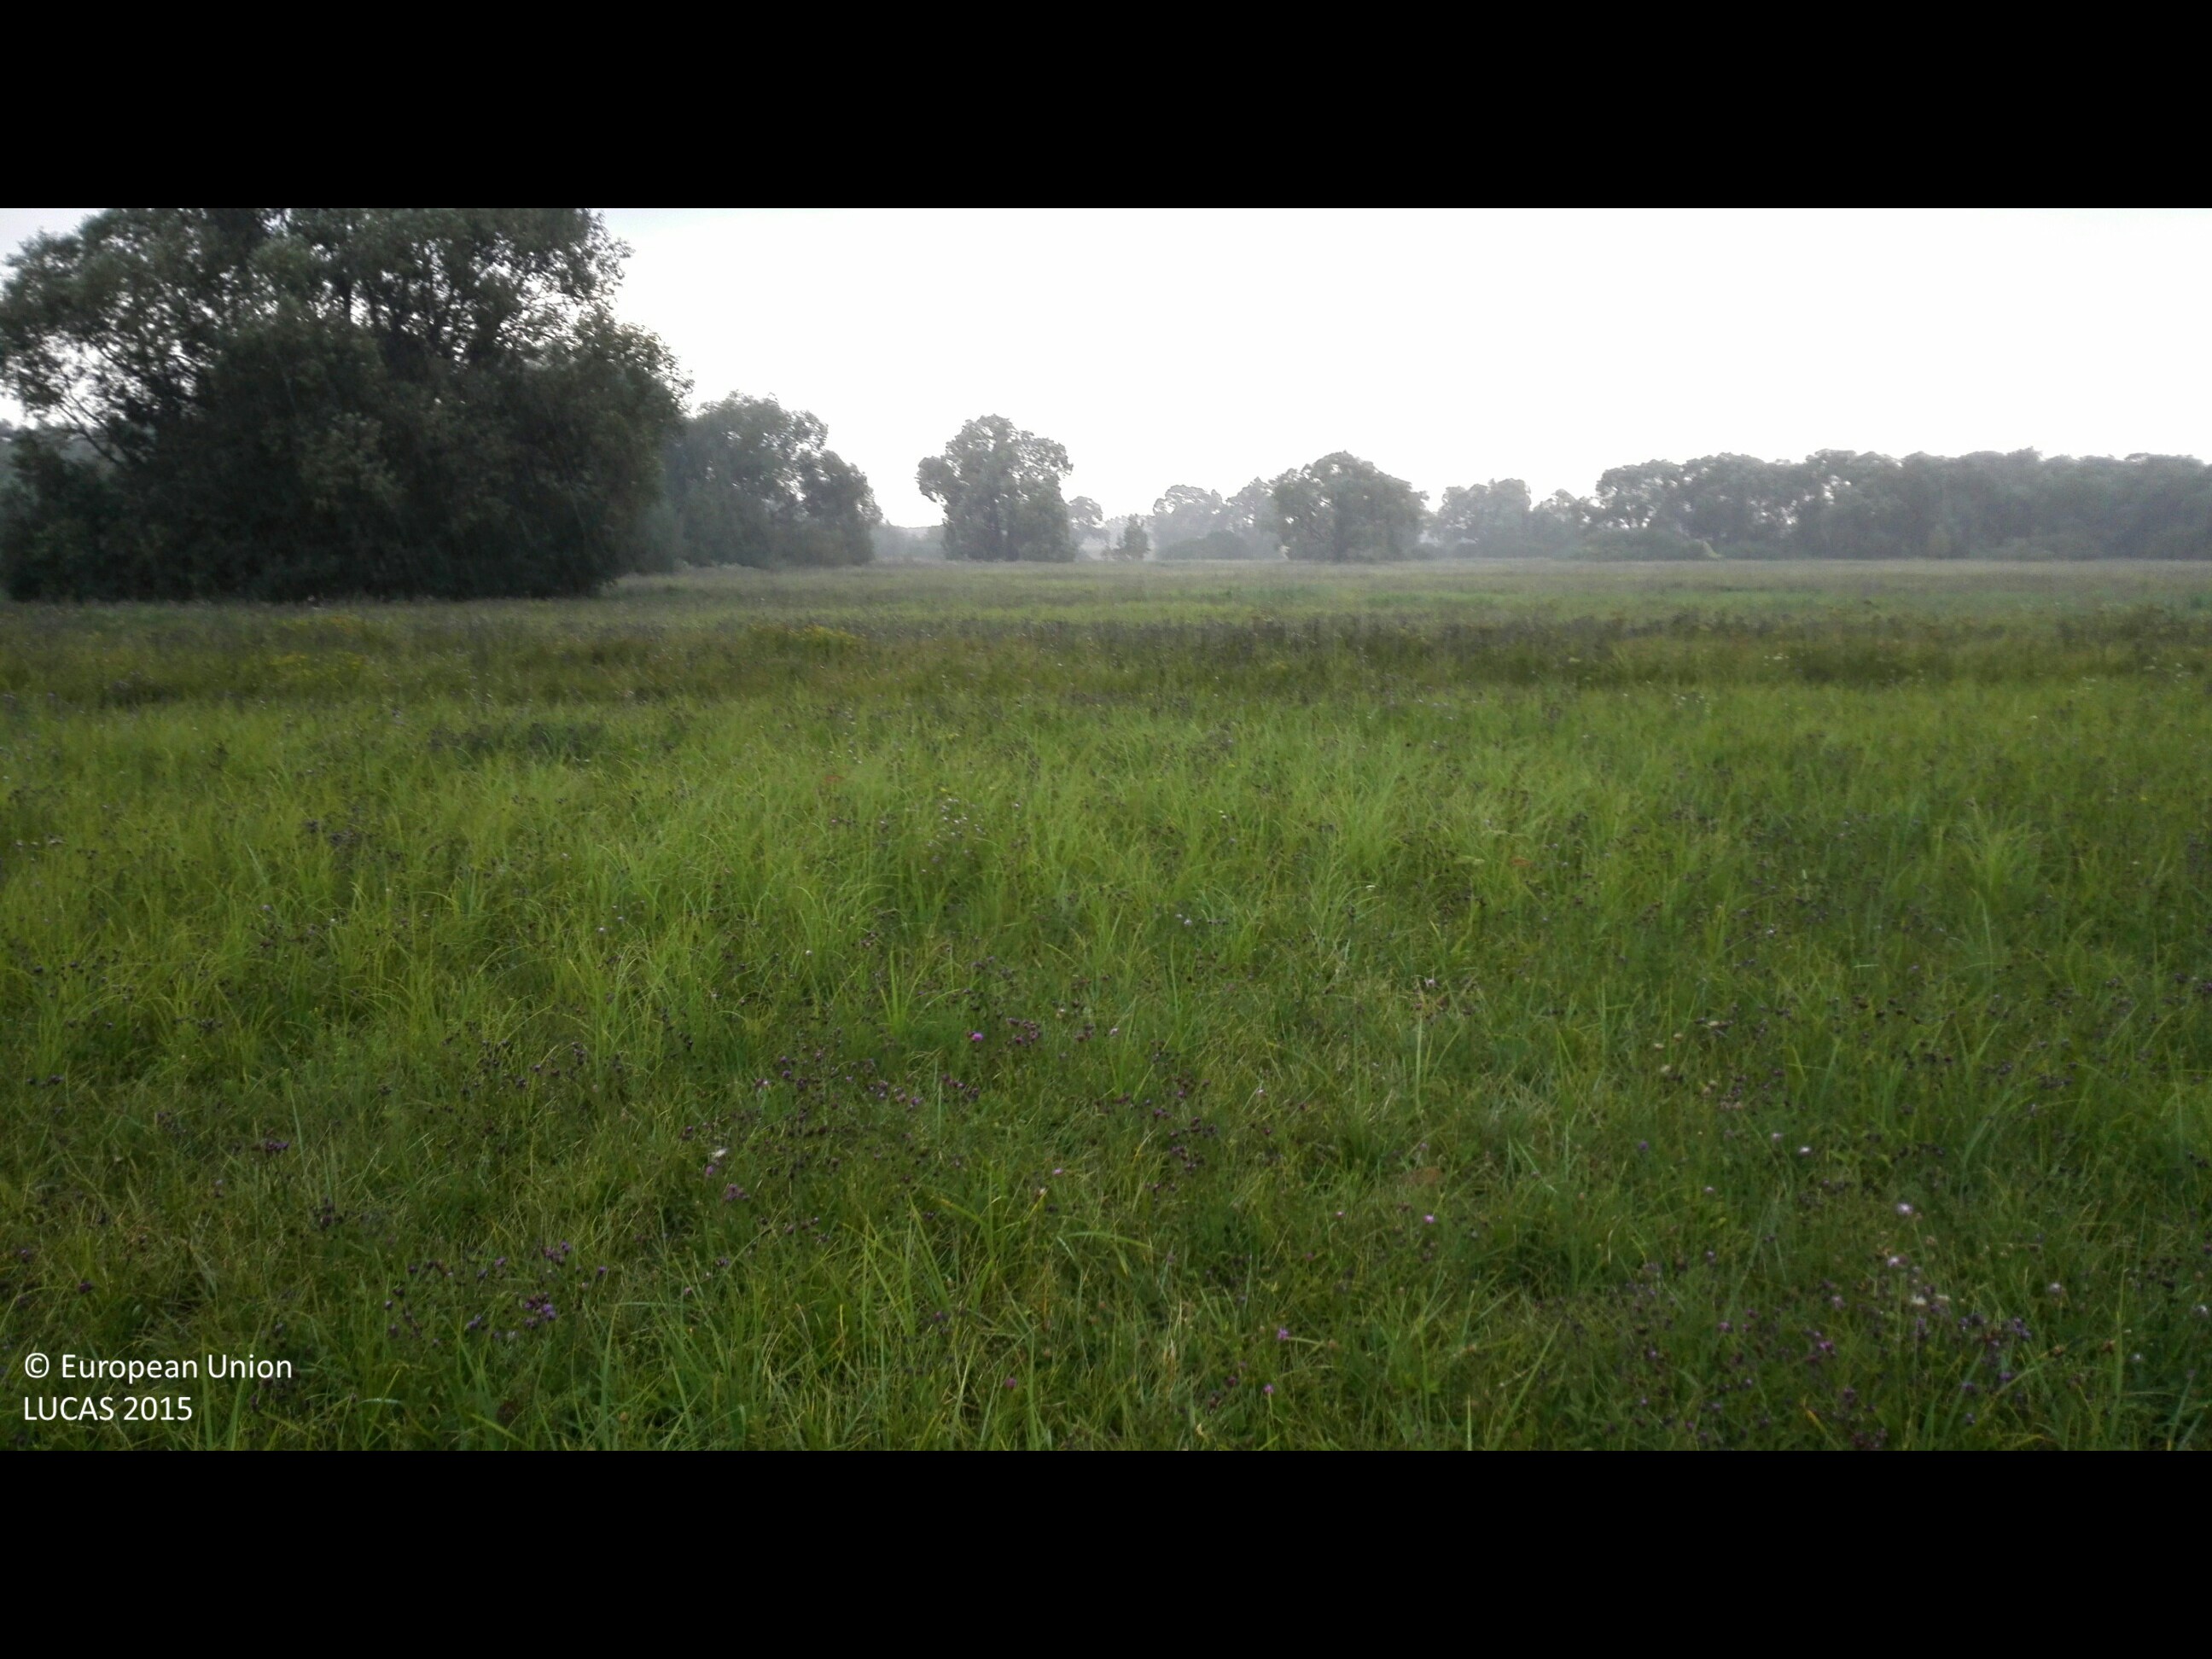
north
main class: Grassland
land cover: Grassland without tree/shrub cover
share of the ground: > 75 %
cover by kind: herbaceous plants 100 %
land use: Agriculture (excluding fallow land and kitchen gardens)
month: August
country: HU
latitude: 47.3819
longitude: 21.8487
